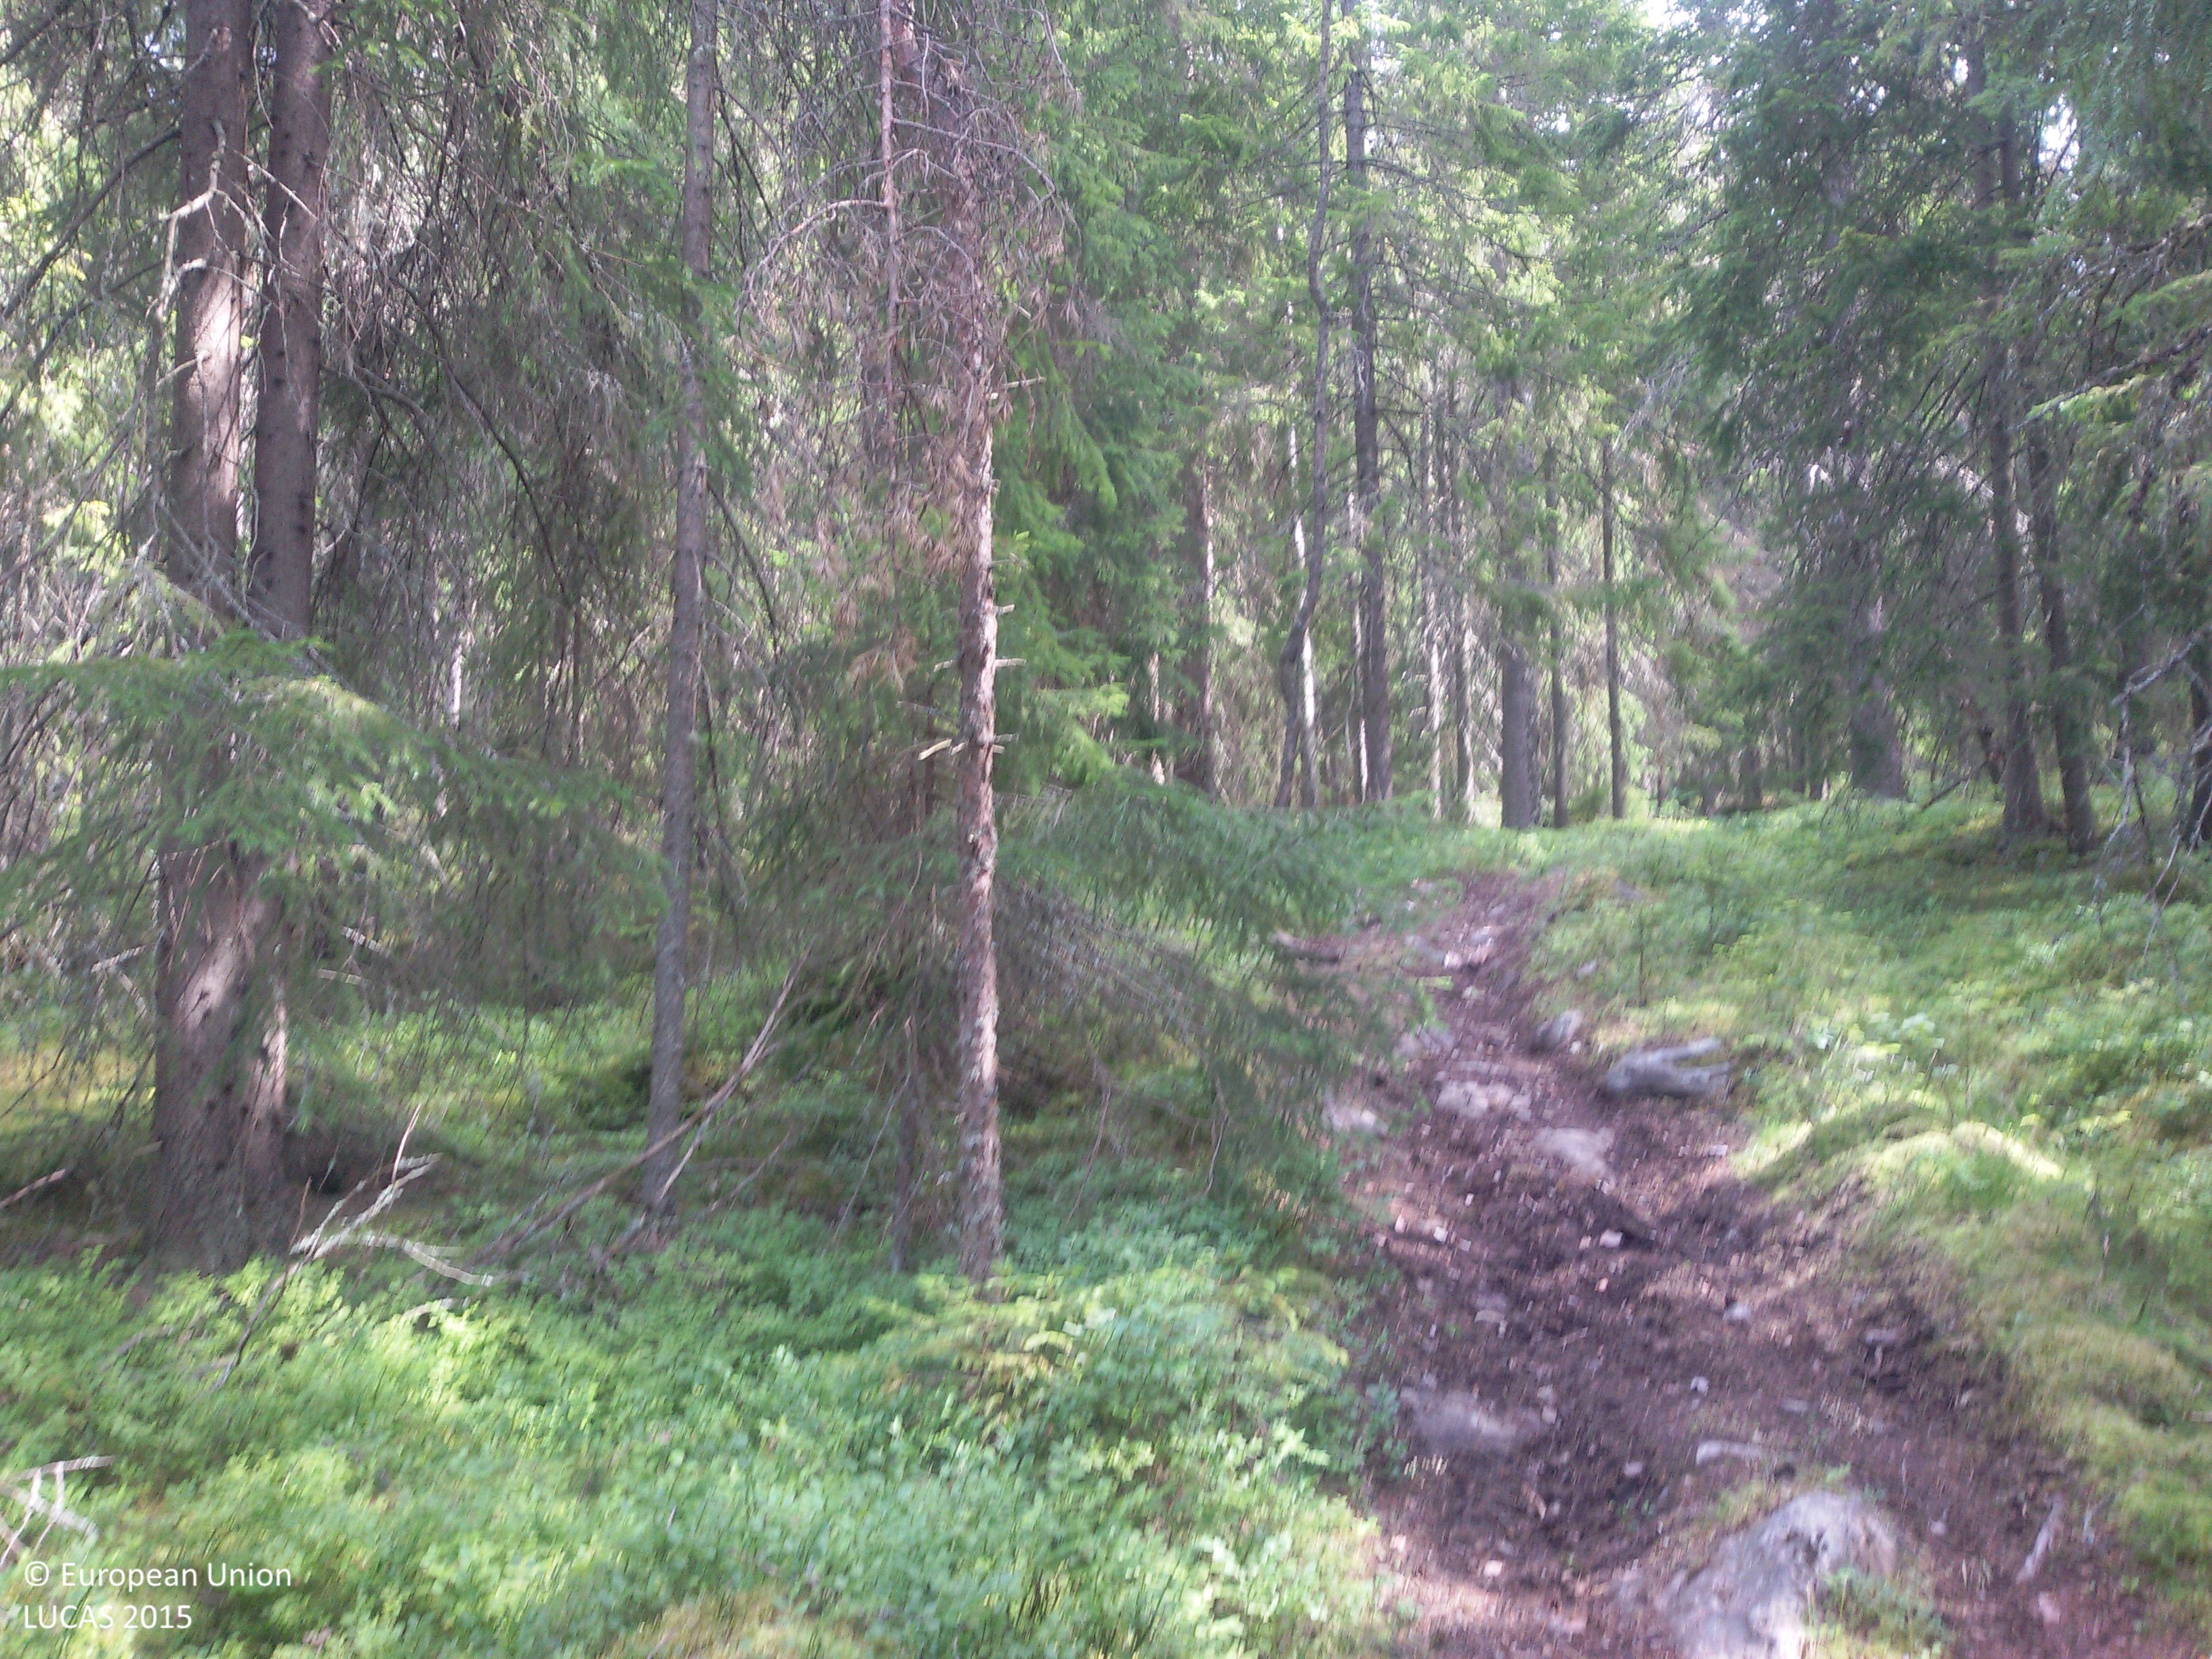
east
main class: Woodland
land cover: Spruce dominated coniferous woodland
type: boreal forest
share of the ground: > 75 %
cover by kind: coniferous forest trees 70 %, herbaceous plants 15 %, broadleaved forest trees 10 %, lichens and mosses 5 %
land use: Forestry
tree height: > 5 m
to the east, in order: Spruce dominated coniferous woodland; Tracks; Spruce dominated coniferous woodland; Tracks; Spruce dominated coniferous woodland
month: July
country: SE
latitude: 60.4485
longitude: 15.6045
